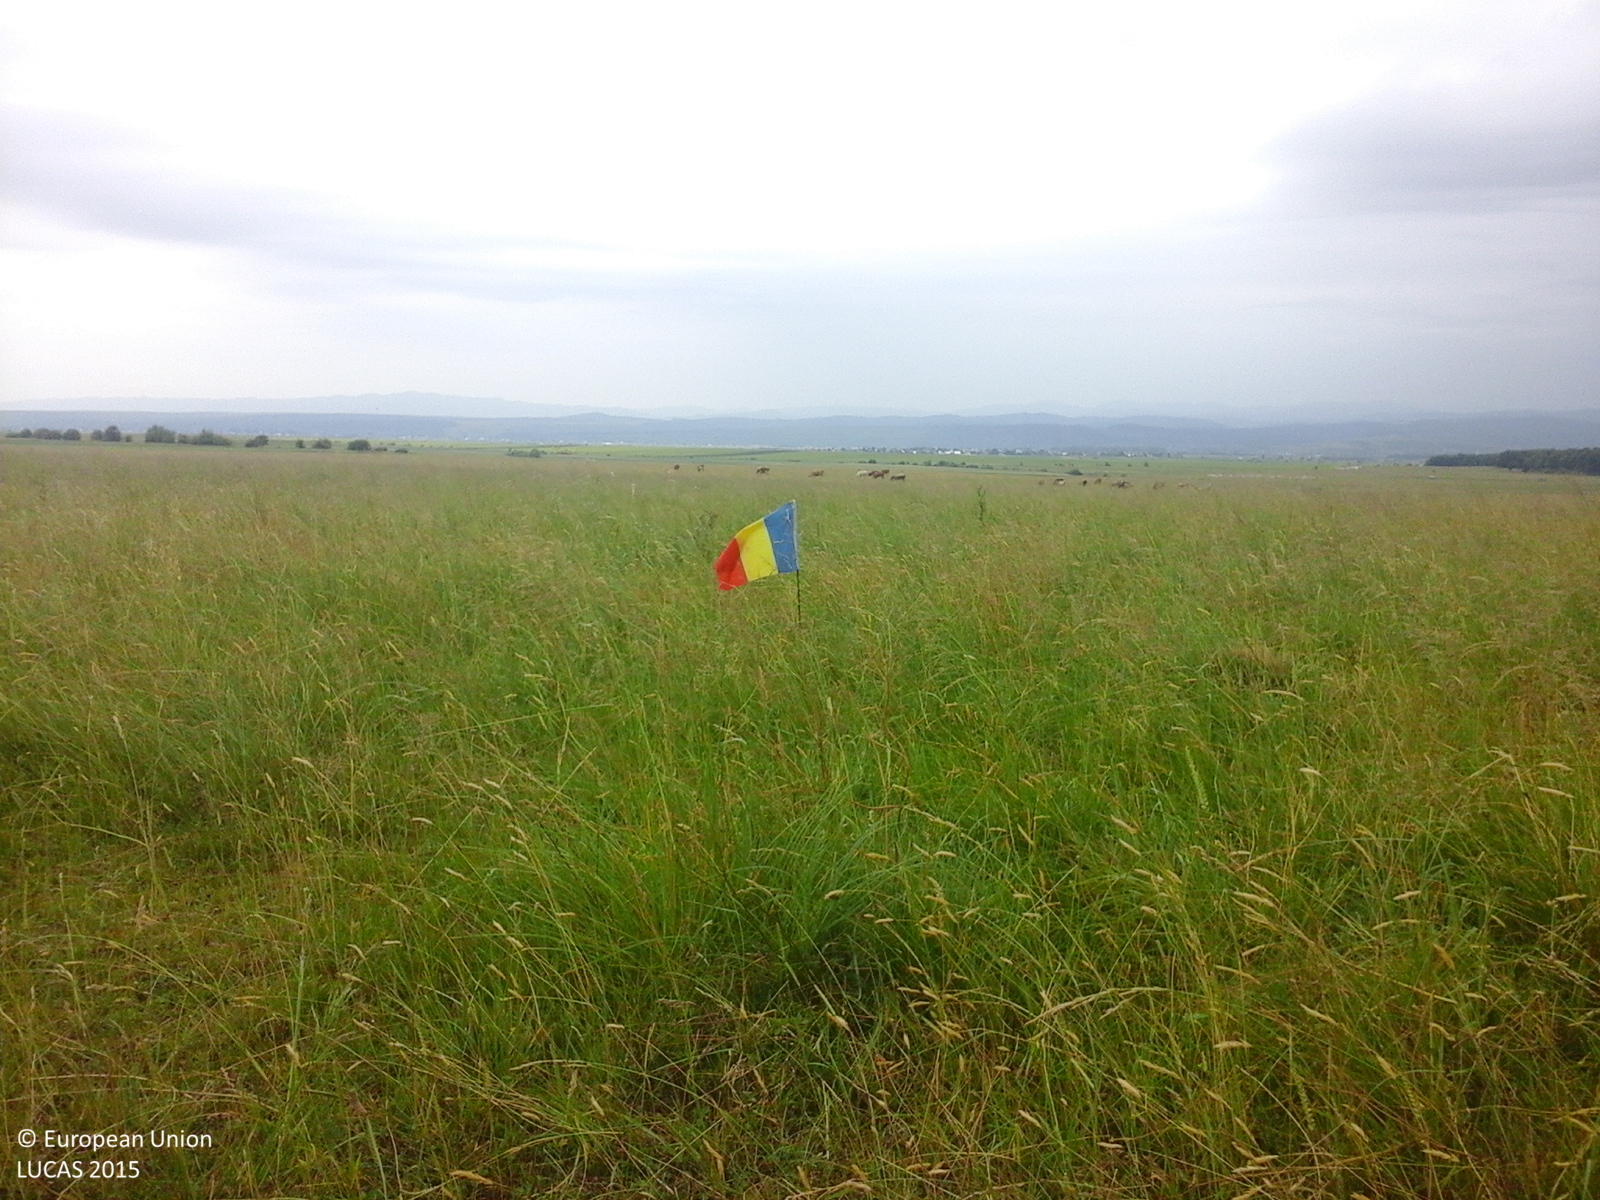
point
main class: Grassland
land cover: Grassland without tree/shrub cover
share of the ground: > 75 %
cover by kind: herbaceous plants 100 %
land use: Agriculture (excluding fallow land and kitchen gardens)
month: June
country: RO
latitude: 47.4907
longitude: 26.2075
